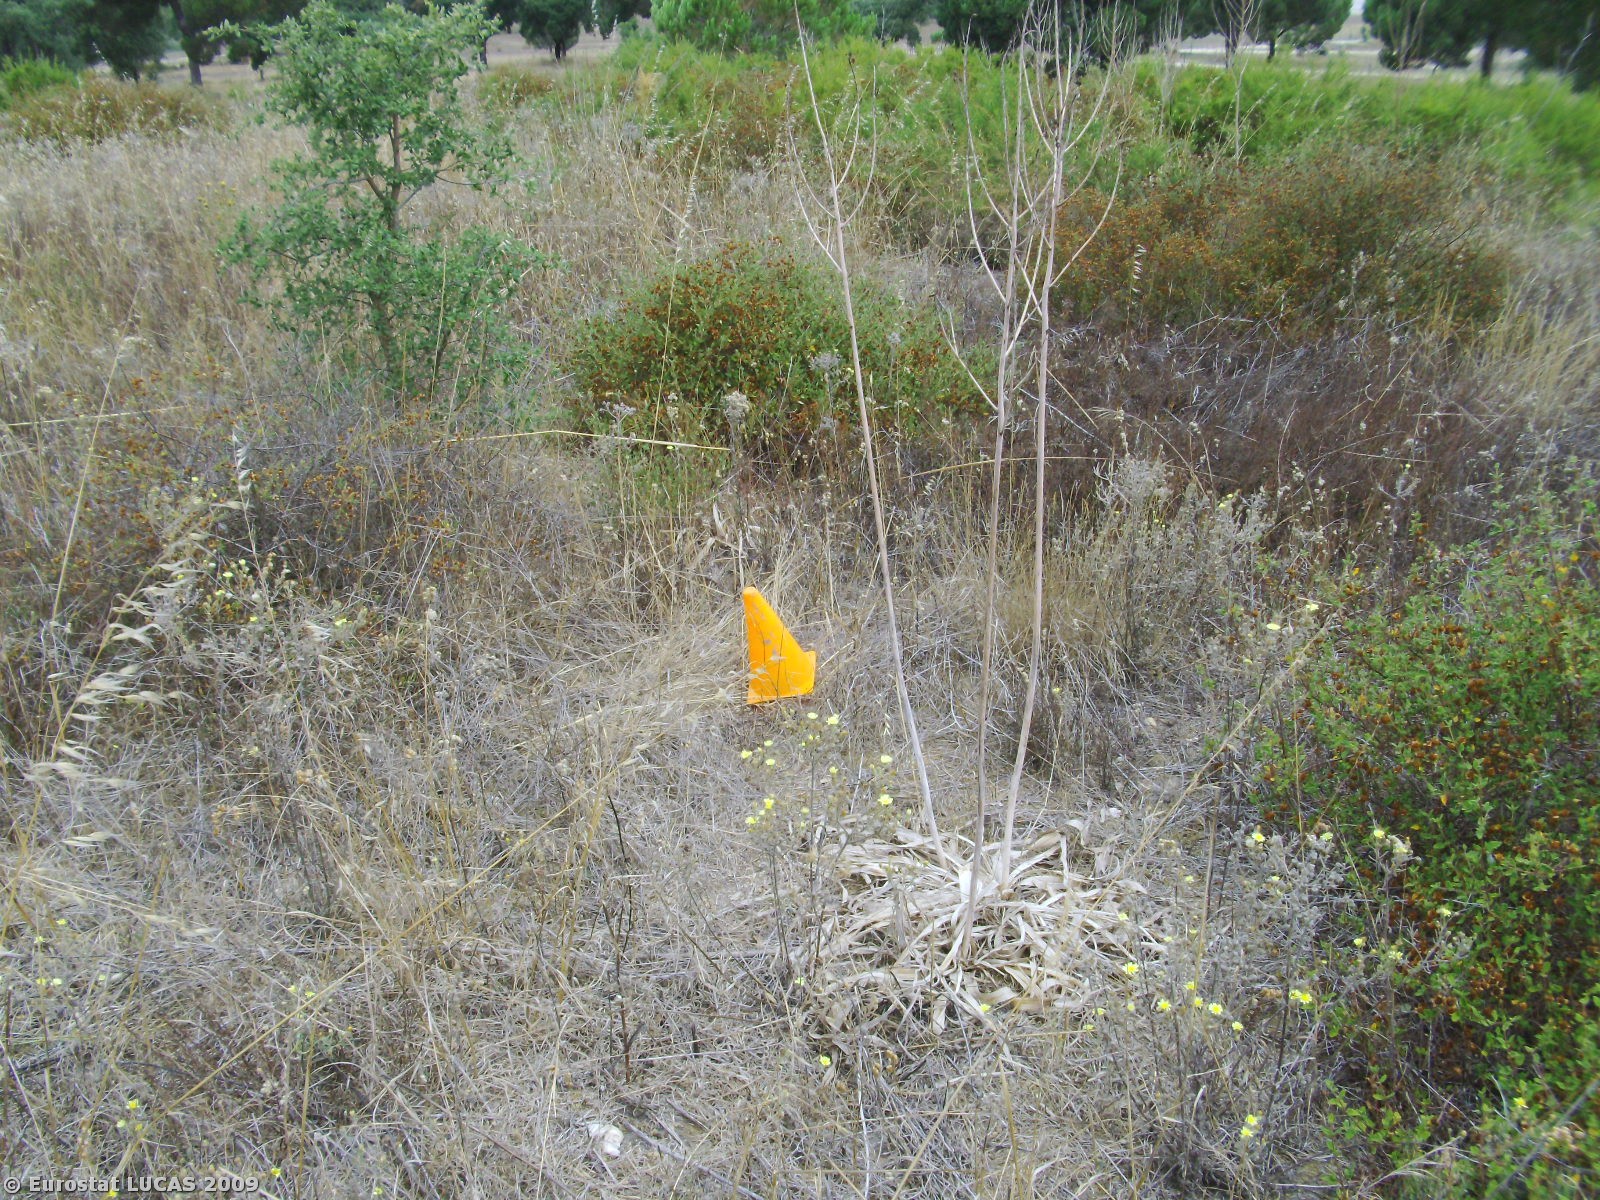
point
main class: Grassland
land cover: Spontaneously vegetated surfaces
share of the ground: > 75 %
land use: Fallow land
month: July
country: PT
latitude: 38.9373
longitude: -8.7698
